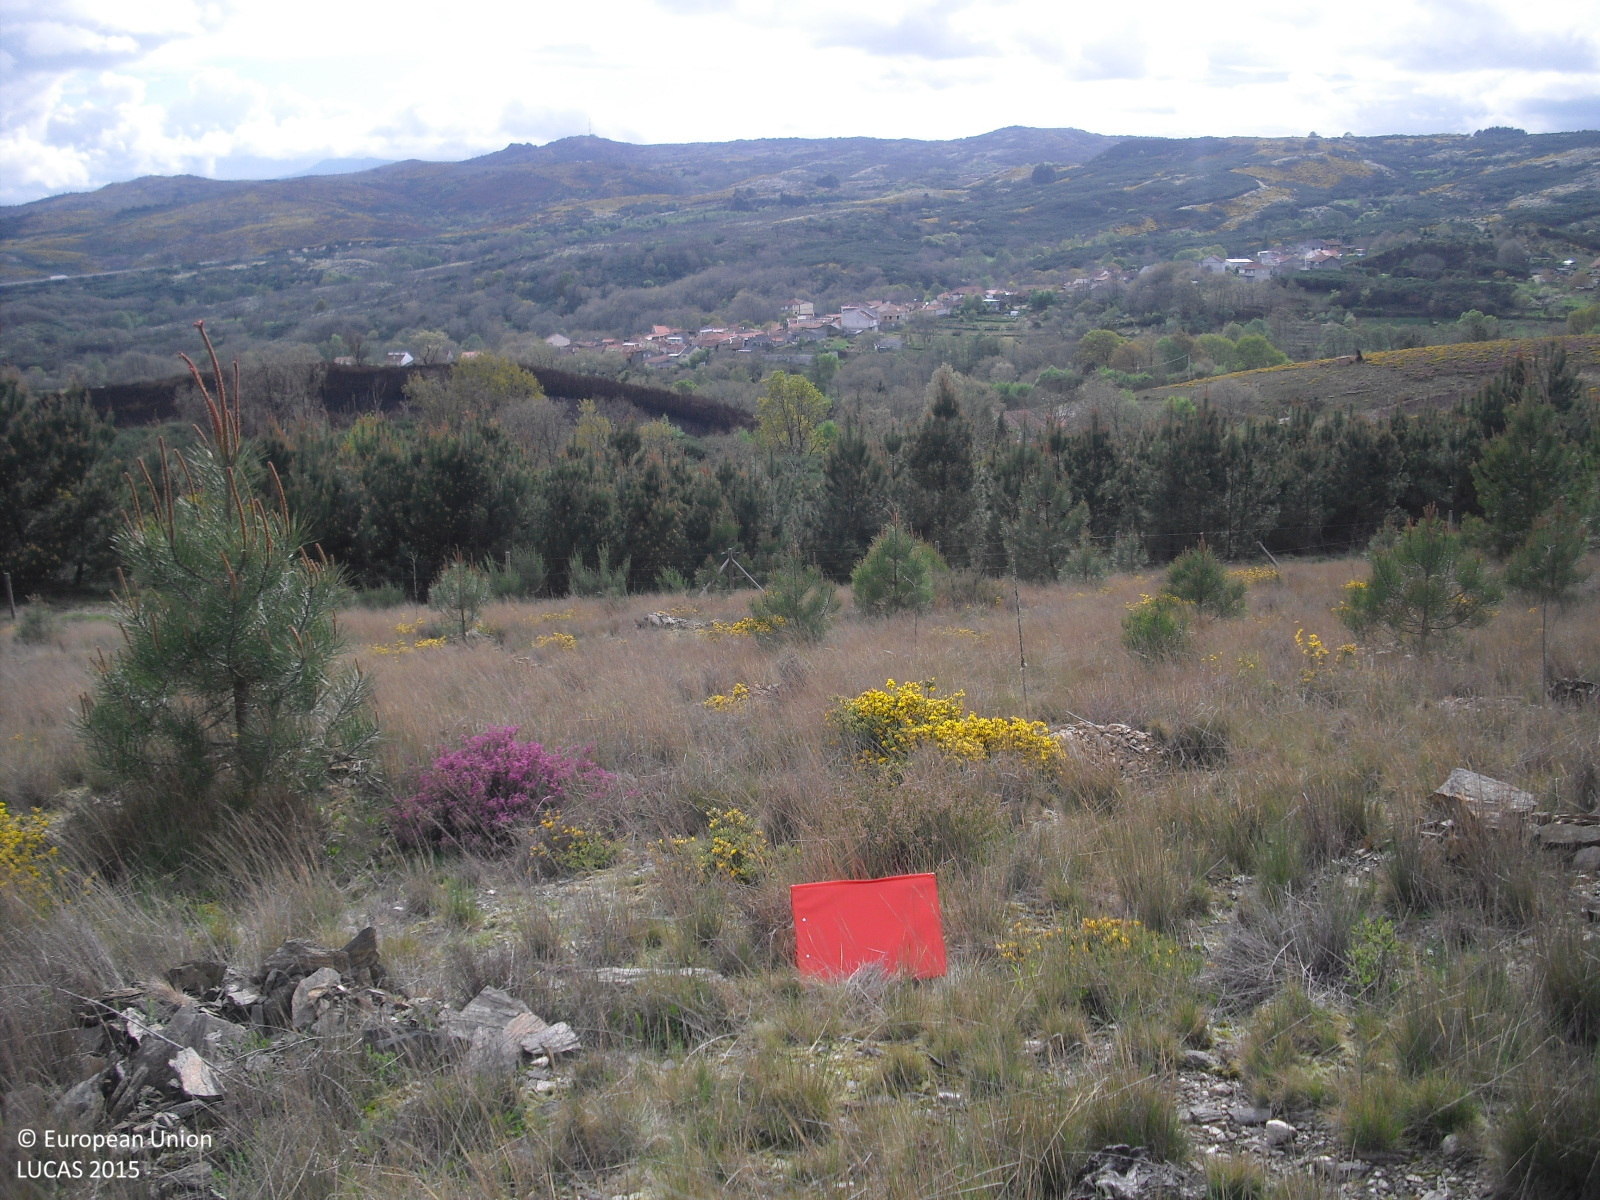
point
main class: Woodland
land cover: Pine dominated coniferous woodland
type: exotic forest
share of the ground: 10 - 25 %
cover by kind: shrubs 30 %, herbaceous plants 30 %, unconsolidated bare surface 30 %, coniferous forest trees 10 %
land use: Forestry
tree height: < 5 m
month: April
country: ES
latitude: 41.9958
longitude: -7.5314
